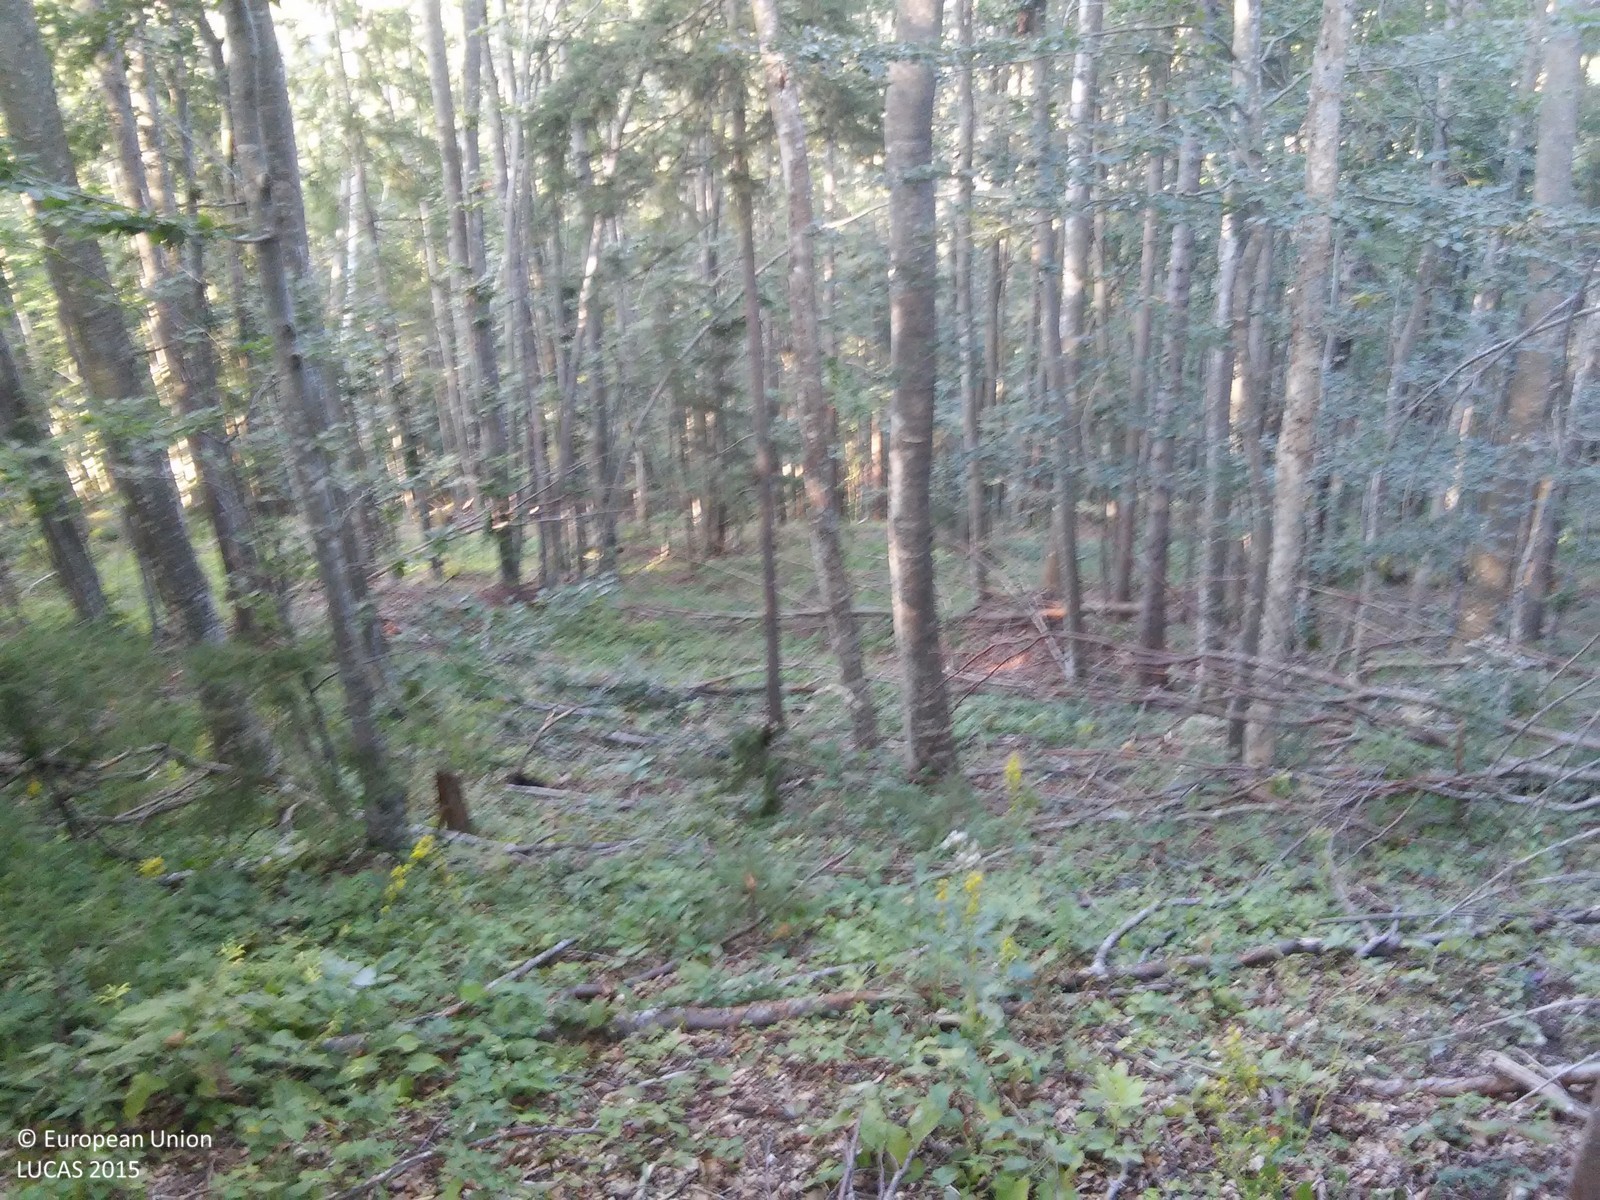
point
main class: Woodland
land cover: Other mixed woodland
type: mountainous beech forest
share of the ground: > 75 %
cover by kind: broadleaved forest trees 75 %, coniferous forest trees 25 %
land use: Forestry
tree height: > 5 m
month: September
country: HR
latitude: 45.6208
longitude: 14.5999
